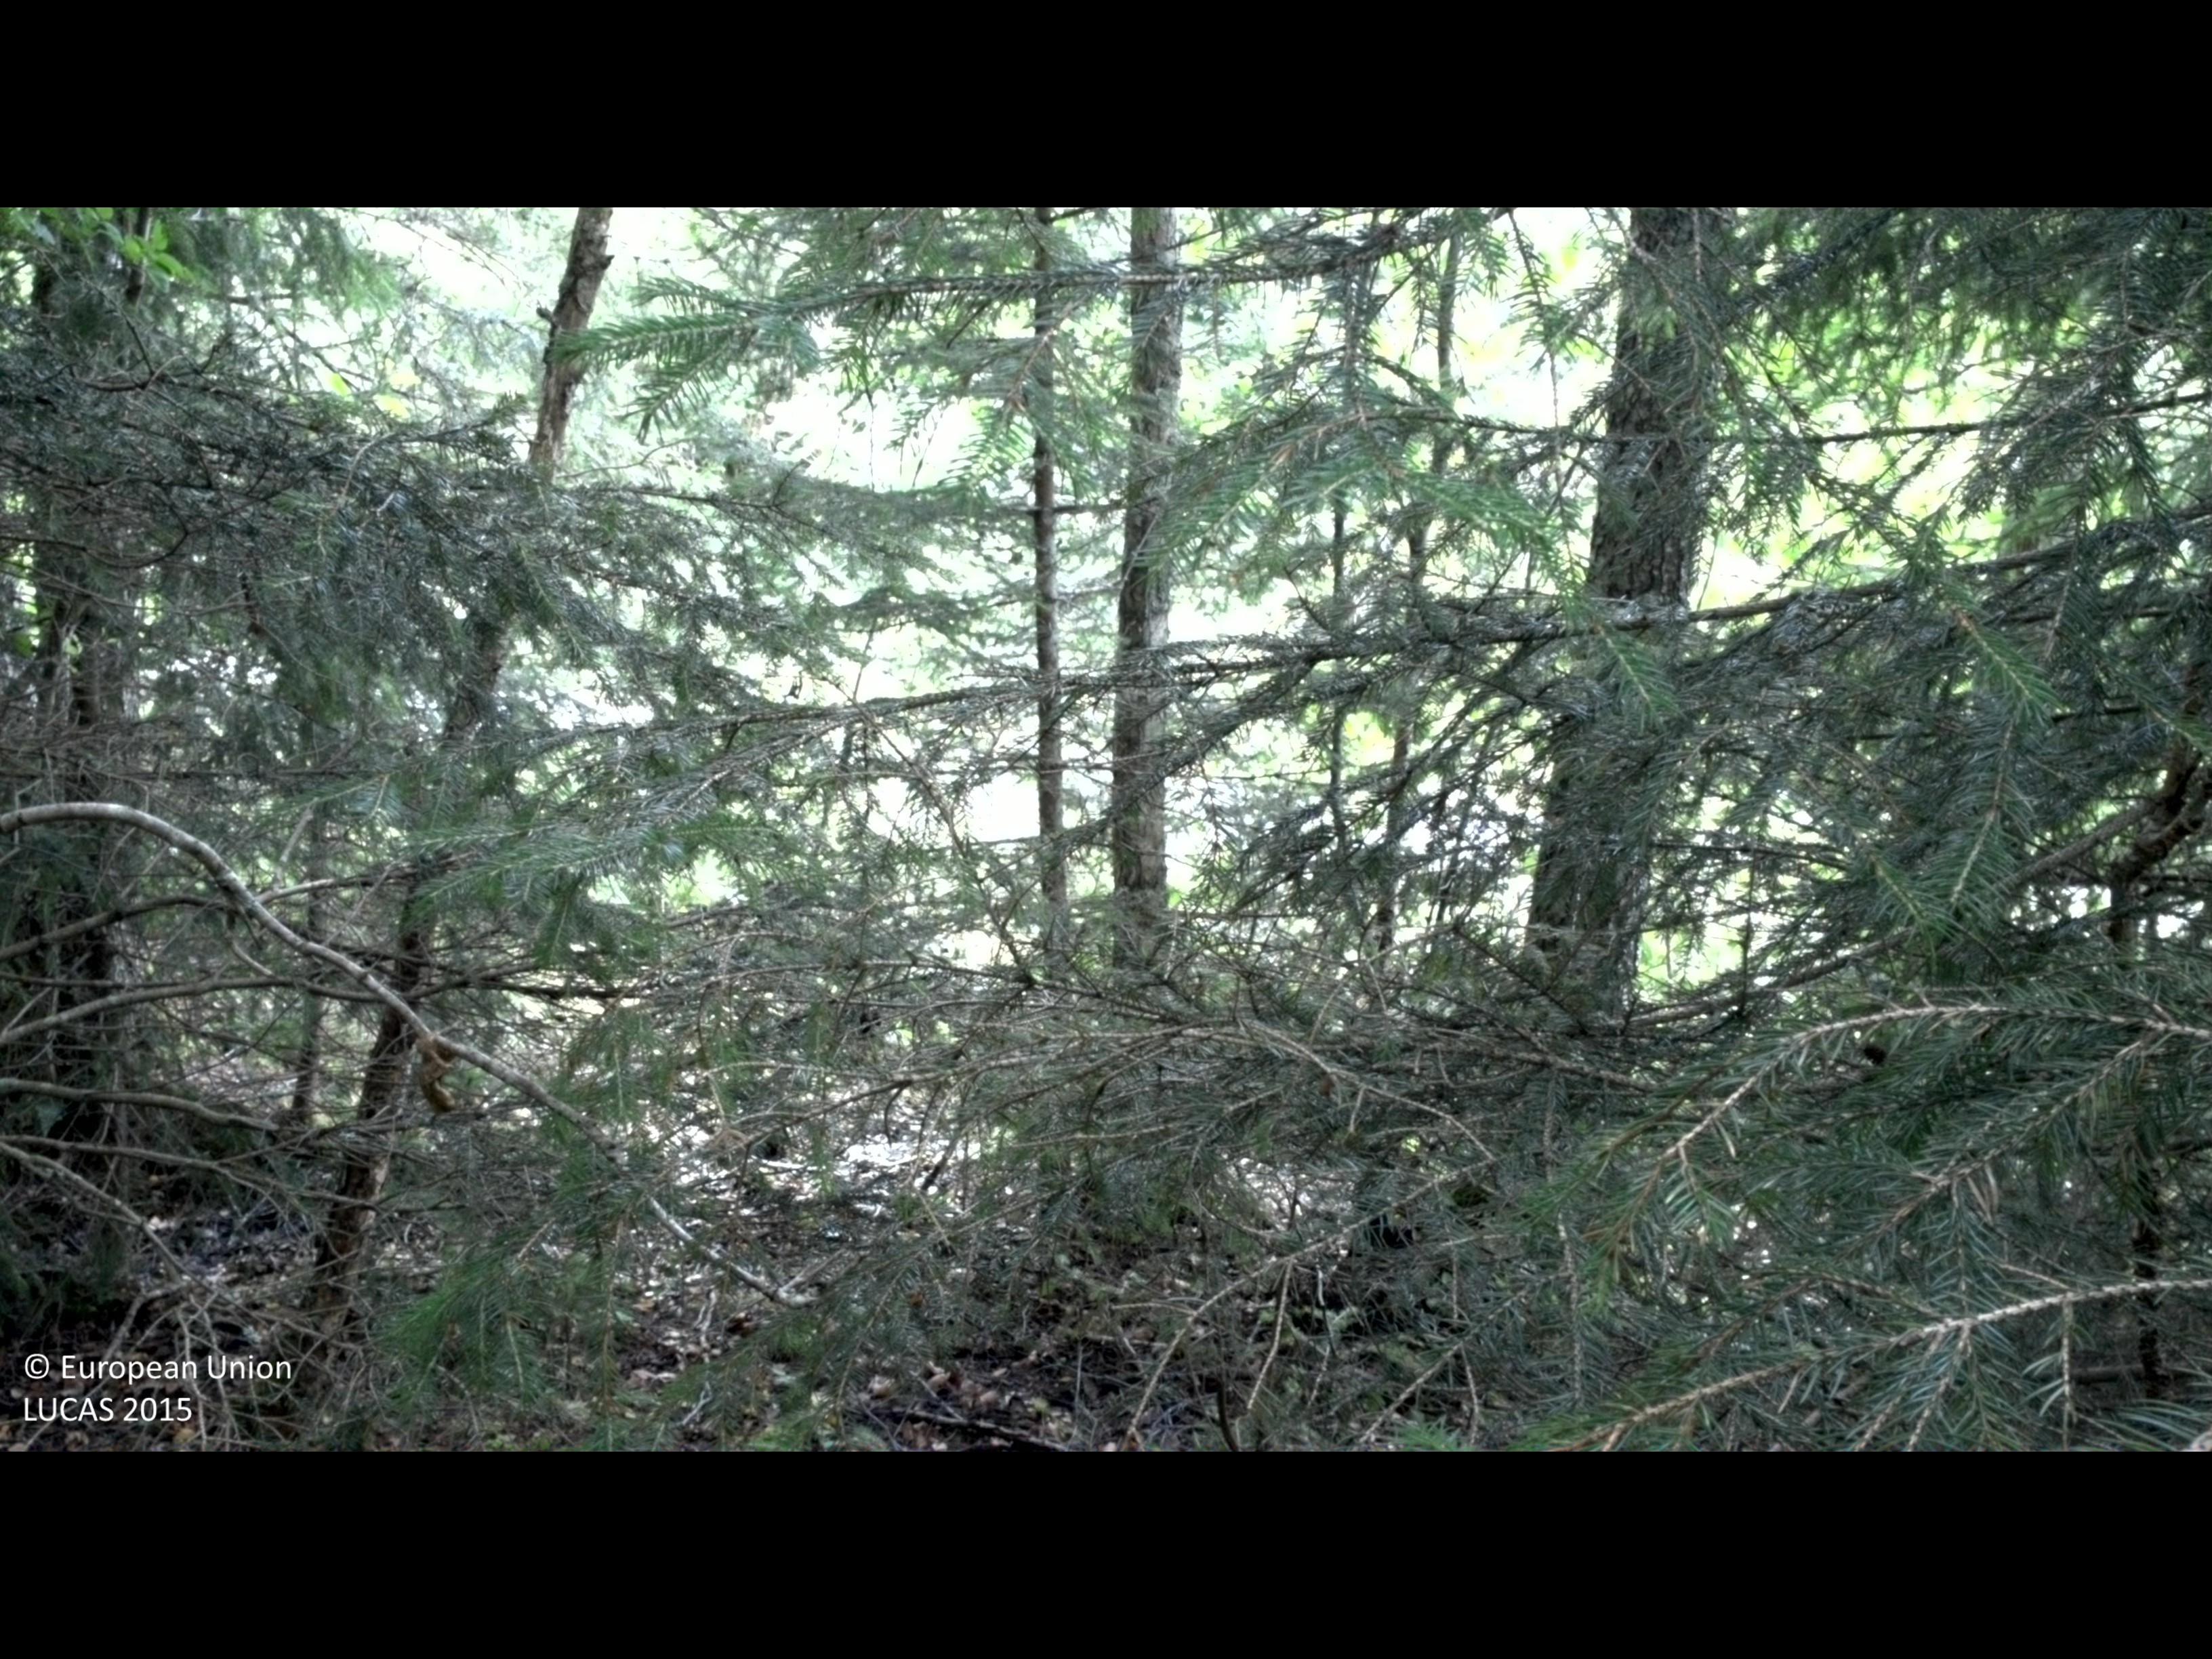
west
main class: Woodland
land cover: Spruce dominated mixed woodland
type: boreal forest
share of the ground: > 75 %
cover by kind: coniferous forest trees 40 %, broadleaved forest trees 40 %, shrubs 15 %, herbaceous plants 5 %
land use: Forestry
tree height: > 5 m
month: July
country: SE
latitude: 58.1503
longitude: 16.1639
